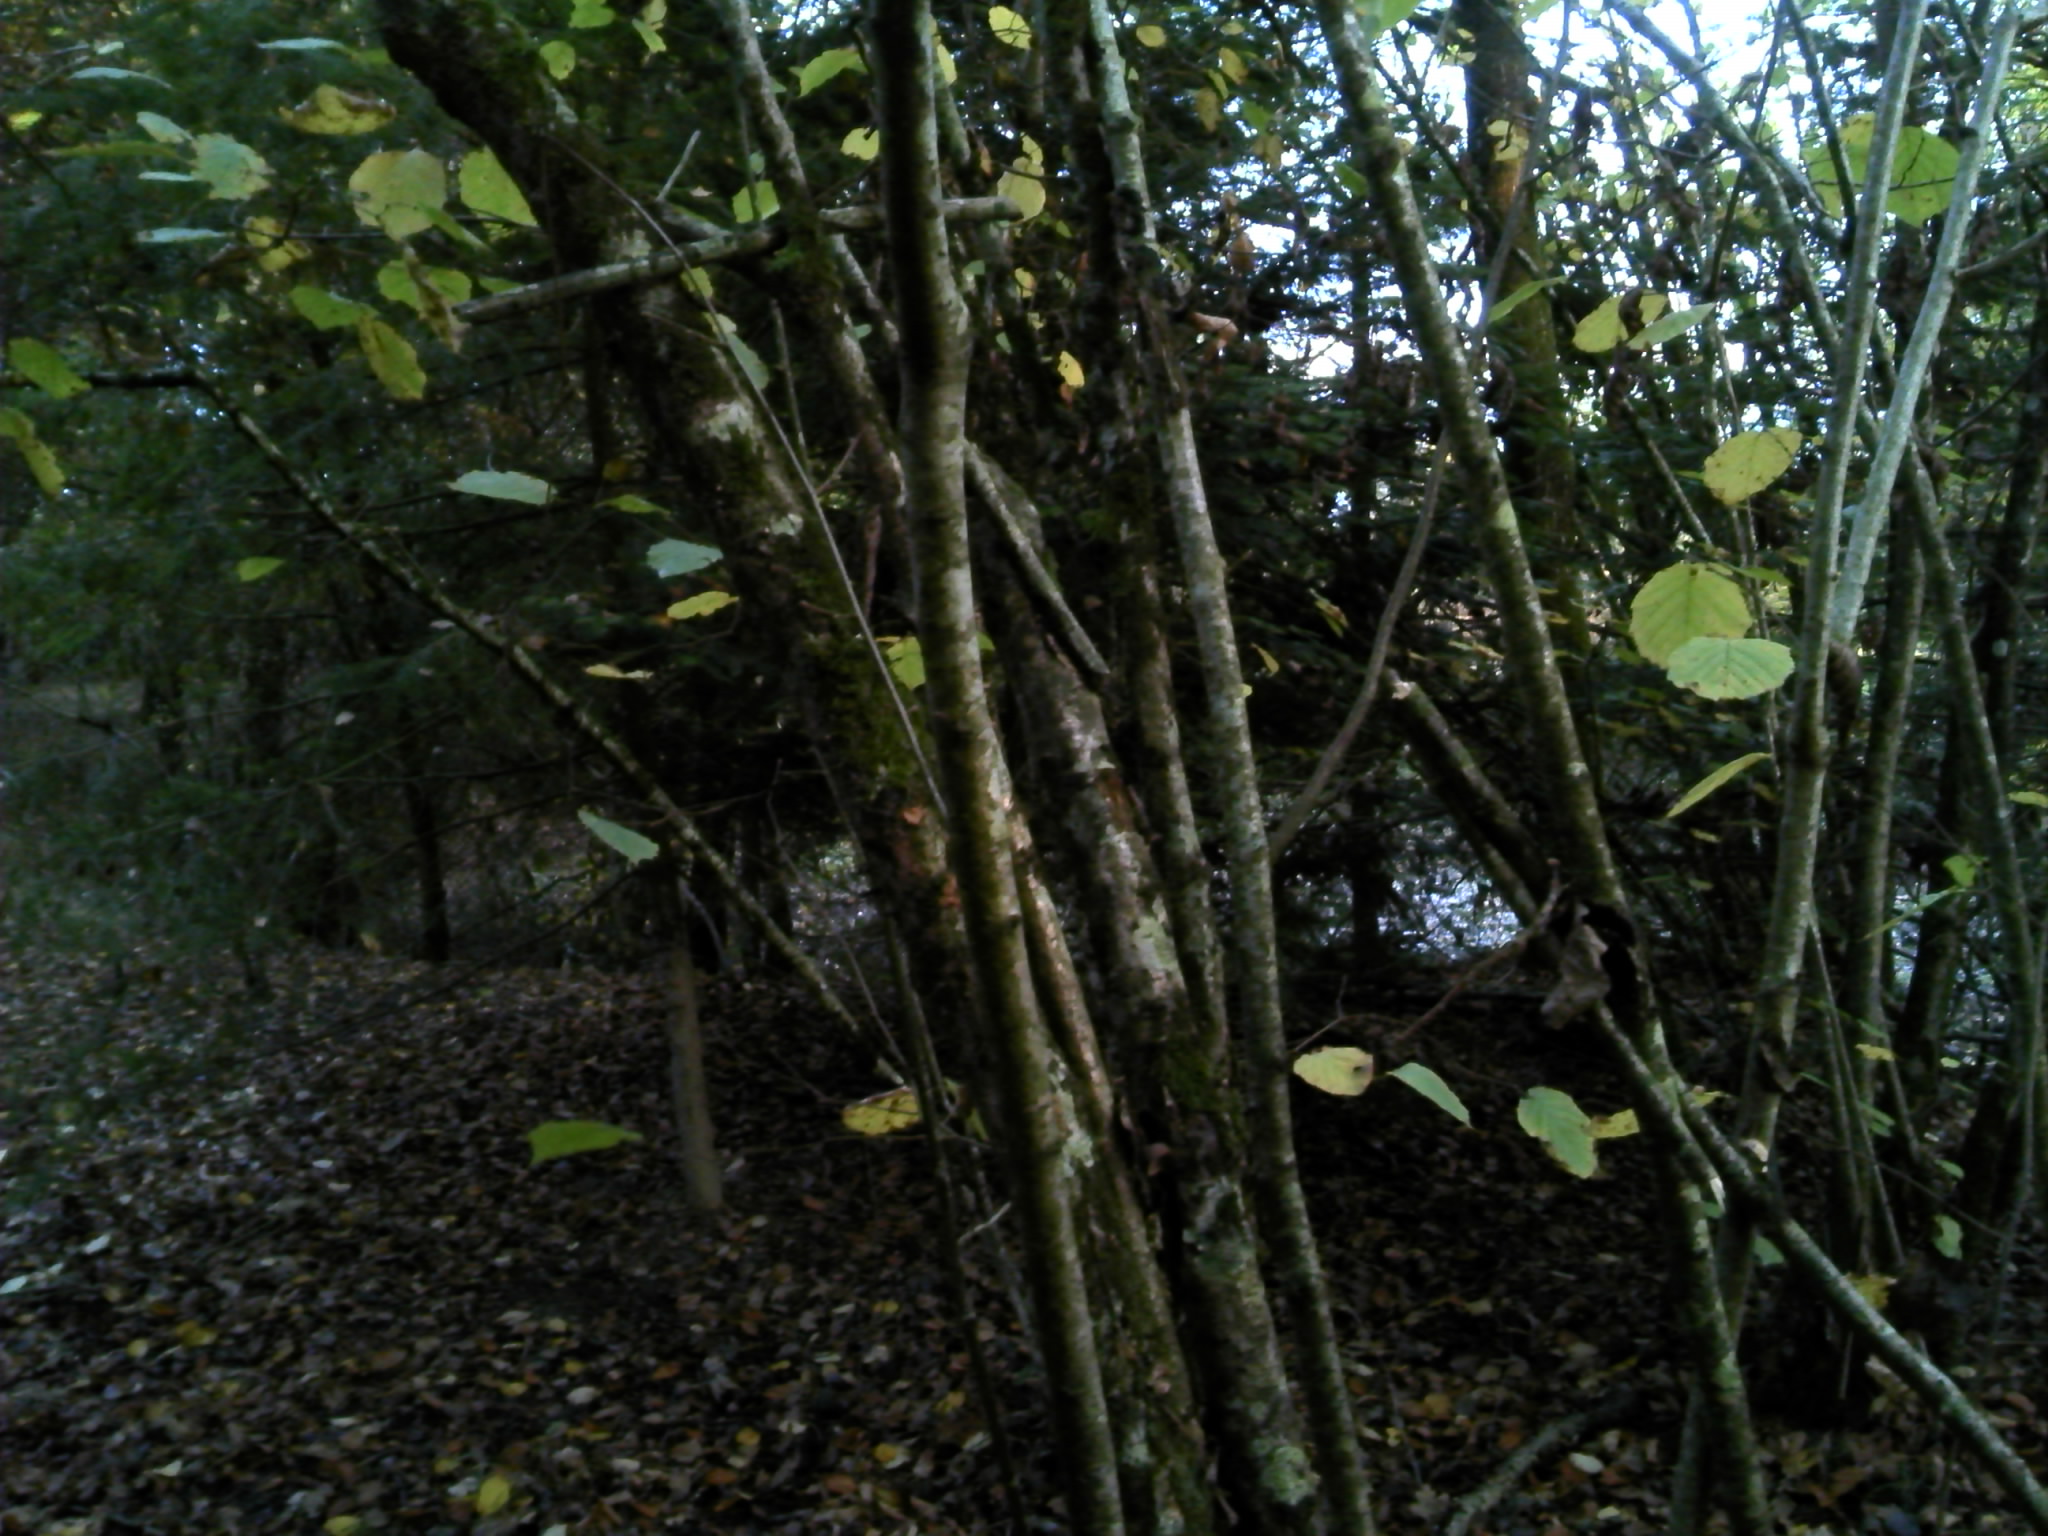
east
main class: Woodland
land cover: Other mixed woodland
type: hemiboreal forest and nemoral coniferous forest and mixed broadleaved-coniferous forest
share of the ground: > 75 %
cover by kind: coniferous forest trees 50 %, broadleaved forest trees 50 %
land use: Forestry
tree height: > 5 m
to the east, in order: Other mixed woodland; Tracks; Shrubland with sparse tree cover; Other mixed woodland
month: November
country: FR
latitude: 47.7372
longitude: -1.0667
